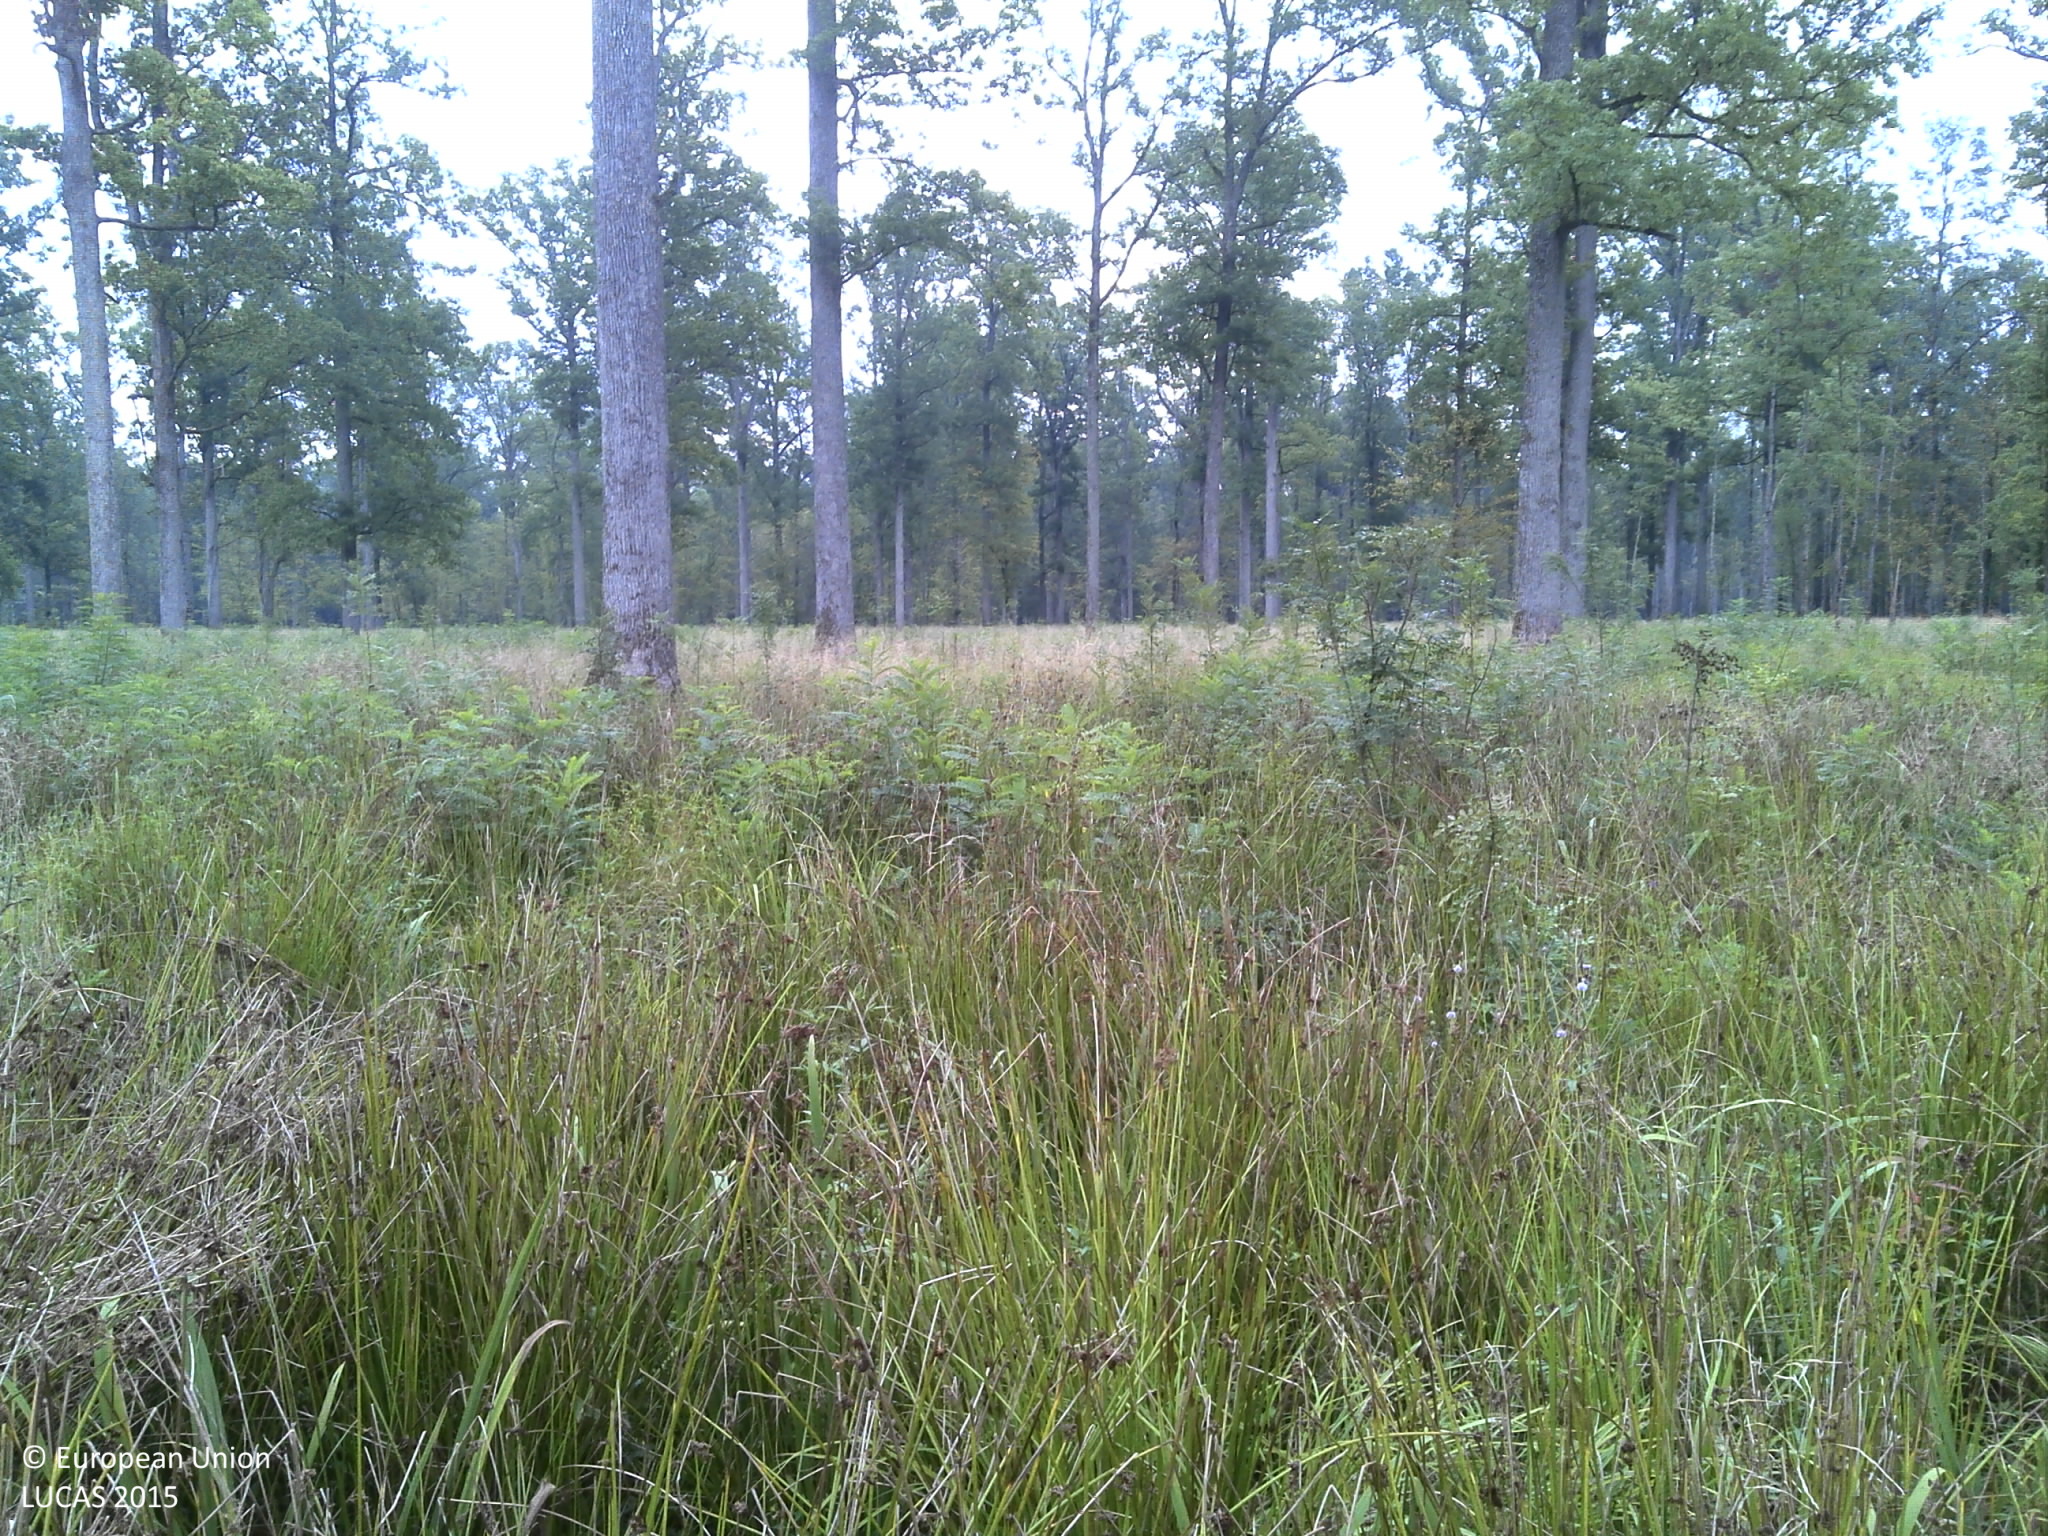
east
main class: Woodland
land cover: Broadleaved woodland
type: acidophilous oak and oak-birch forest
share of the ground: 25 - 50 %
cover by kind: herbaceous plants 60 %, broadleaved forest trees 40 %
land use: Forestry
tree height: > 5 m
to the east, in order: Broadleaved woodland
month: August
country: HR
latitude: 45.2887
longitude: 16.7429
